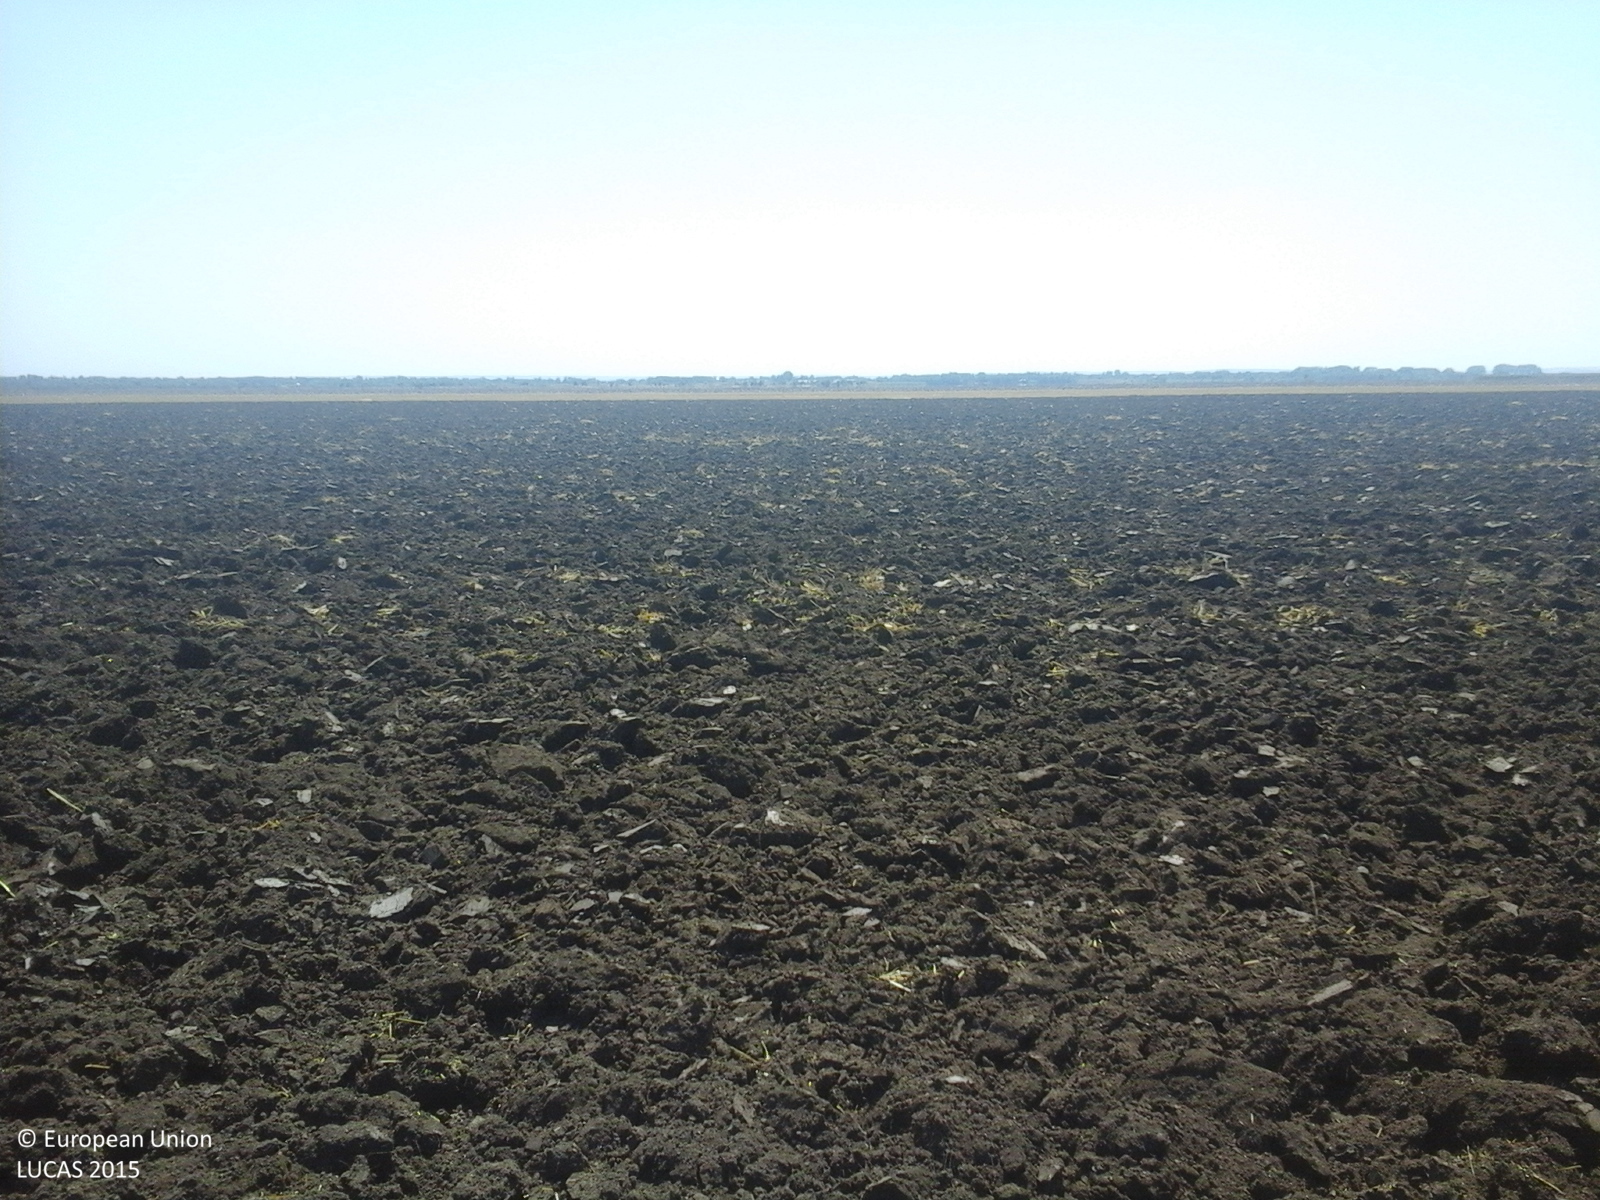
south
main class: Cropland
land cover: Common wheat
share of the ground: < 10 %
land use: Agriculture (excluding fallow land and kitchen gardens)
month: July
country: RO
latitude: 44.2358
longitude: 27.1454
